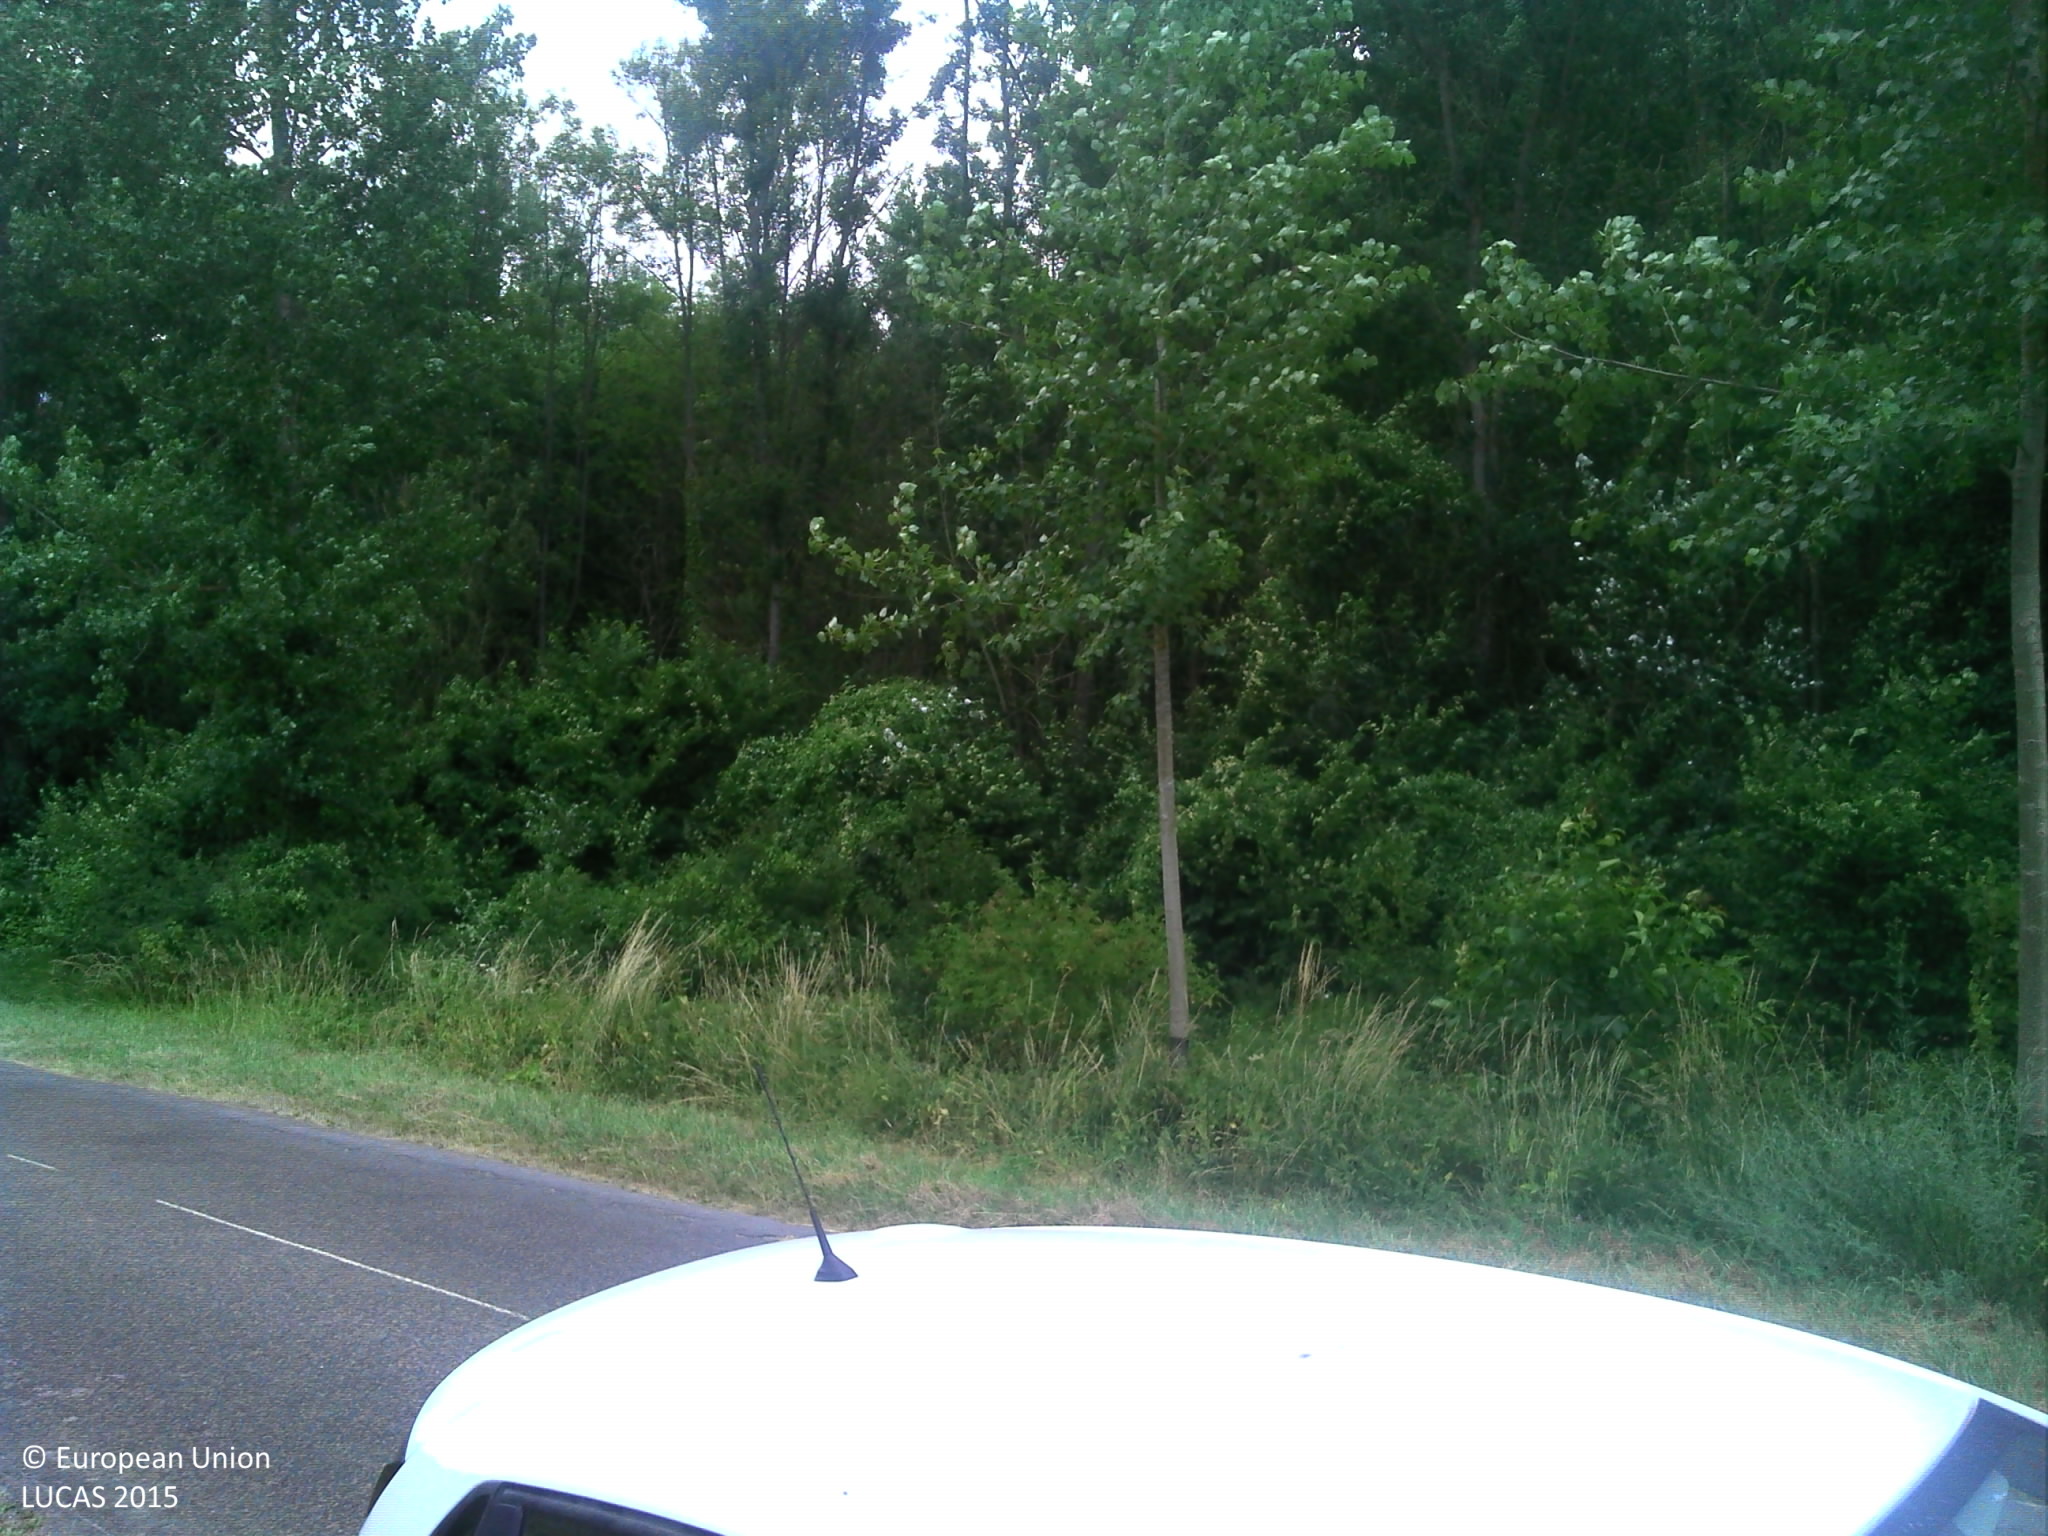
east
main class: Grassland
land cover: Grassland without tree/shrub cover
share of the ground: > 75 %
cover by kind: herbaceous plants 100 %
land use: Agriculture (excluding fallow land and kitchen gardens)
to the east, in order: Grassland without tree/shrub cover; Fences; Grass margins; Paved roads, cycling and walking lanes; Grass margins; Broadleaved woodland; Rivers and streams; Broadleaved woodland
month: July
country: FR
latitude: 49.2680
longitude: 3.6581
